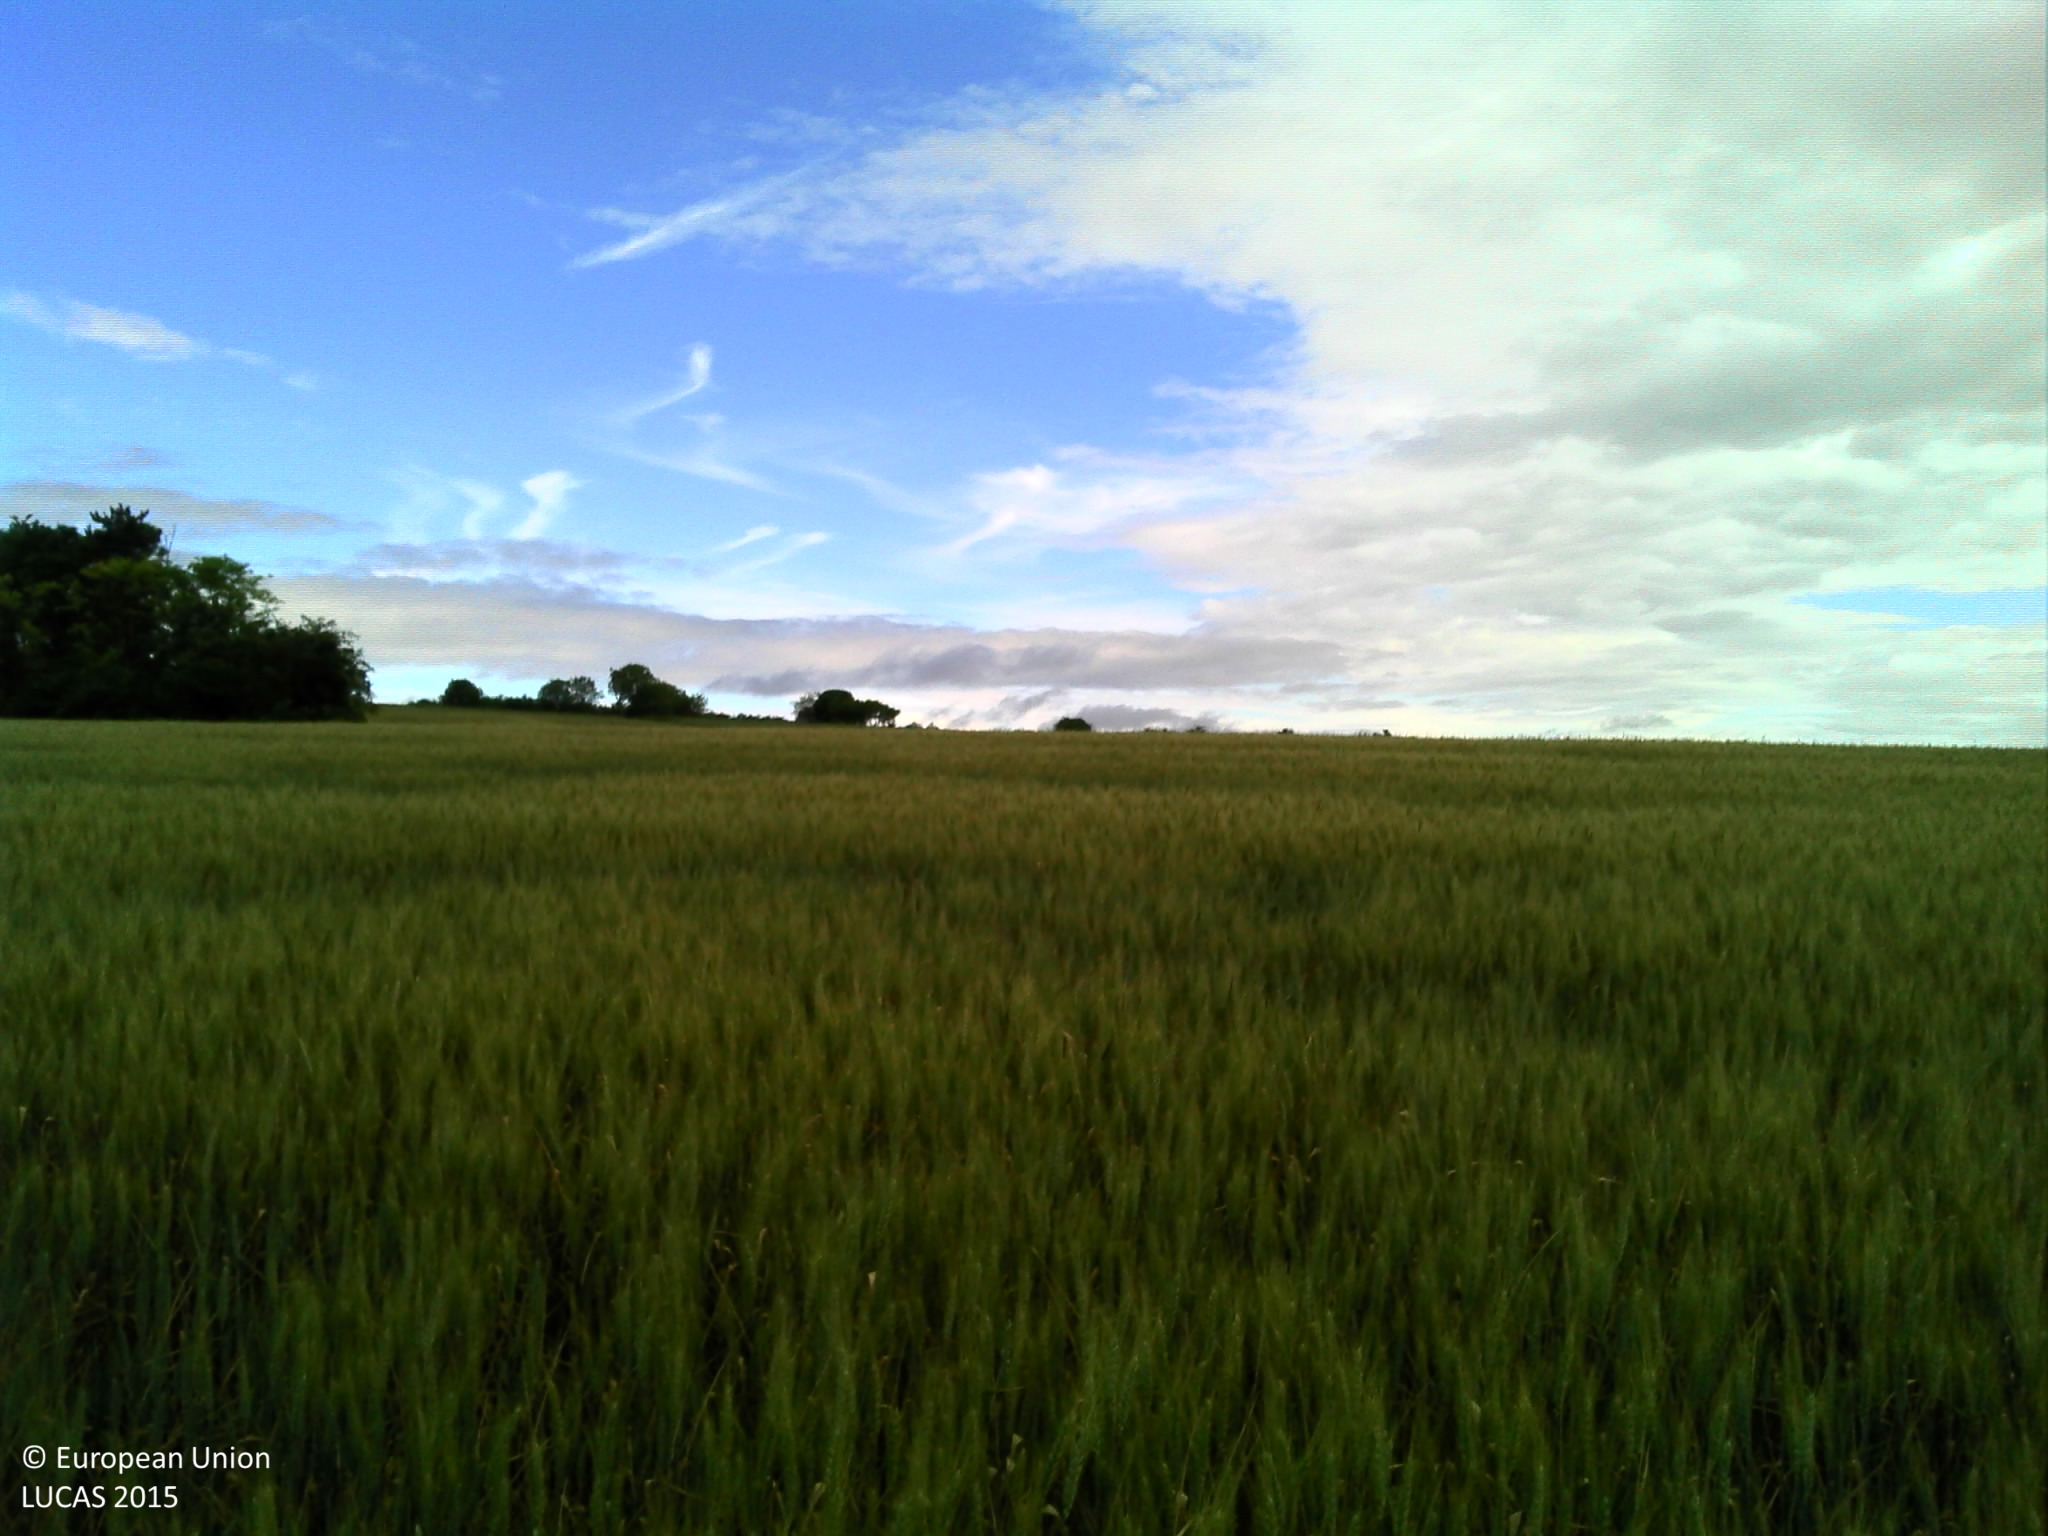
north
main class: Cropland
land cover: Durum wheat
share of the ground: > 75 %
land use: Agriculture (excluding fallow land and kitchen gardens)
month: June
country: FR
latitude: 47.3736
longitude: 5.0606
